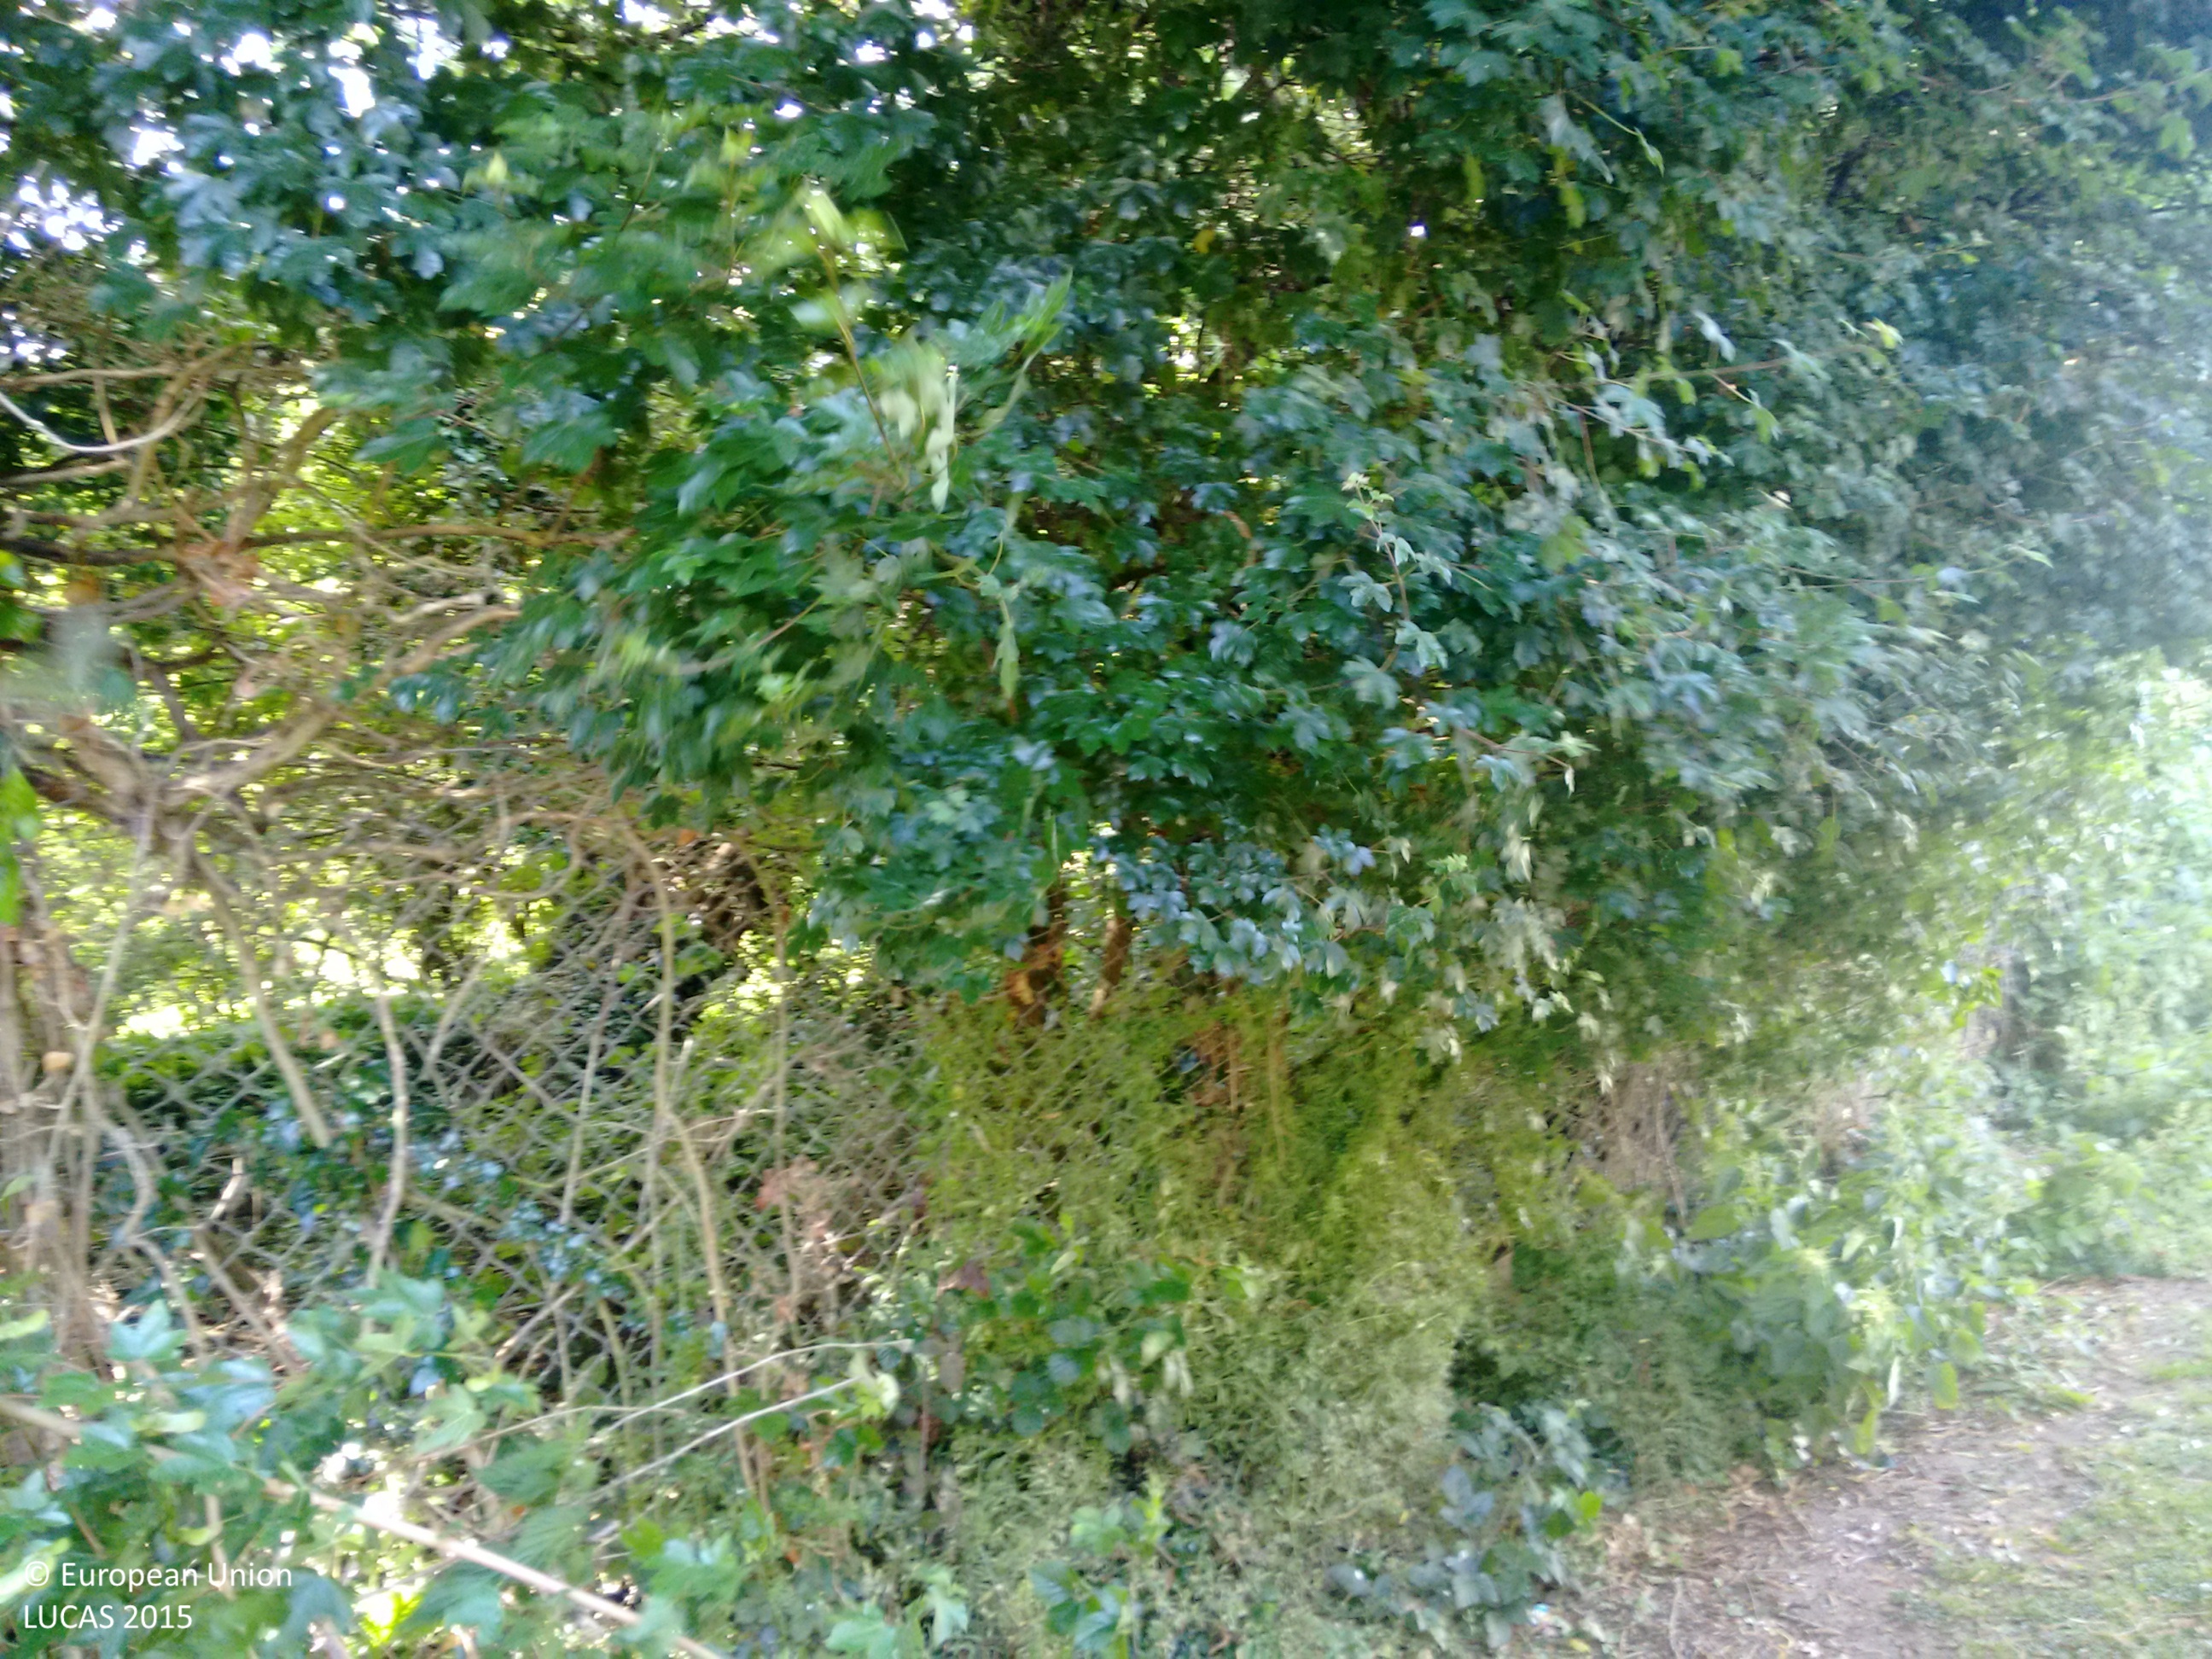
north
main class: Woodland
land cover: Broadleaved woodland
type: mesophytic deciduous forest
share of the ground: > 75 %
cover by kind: broadleaved forest trees 60 %, shrubs 40 %
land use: Semi-natural and natural areas not in use
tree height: > 5 m
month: June
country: GB
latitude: 50.8572
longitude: 0.5255
